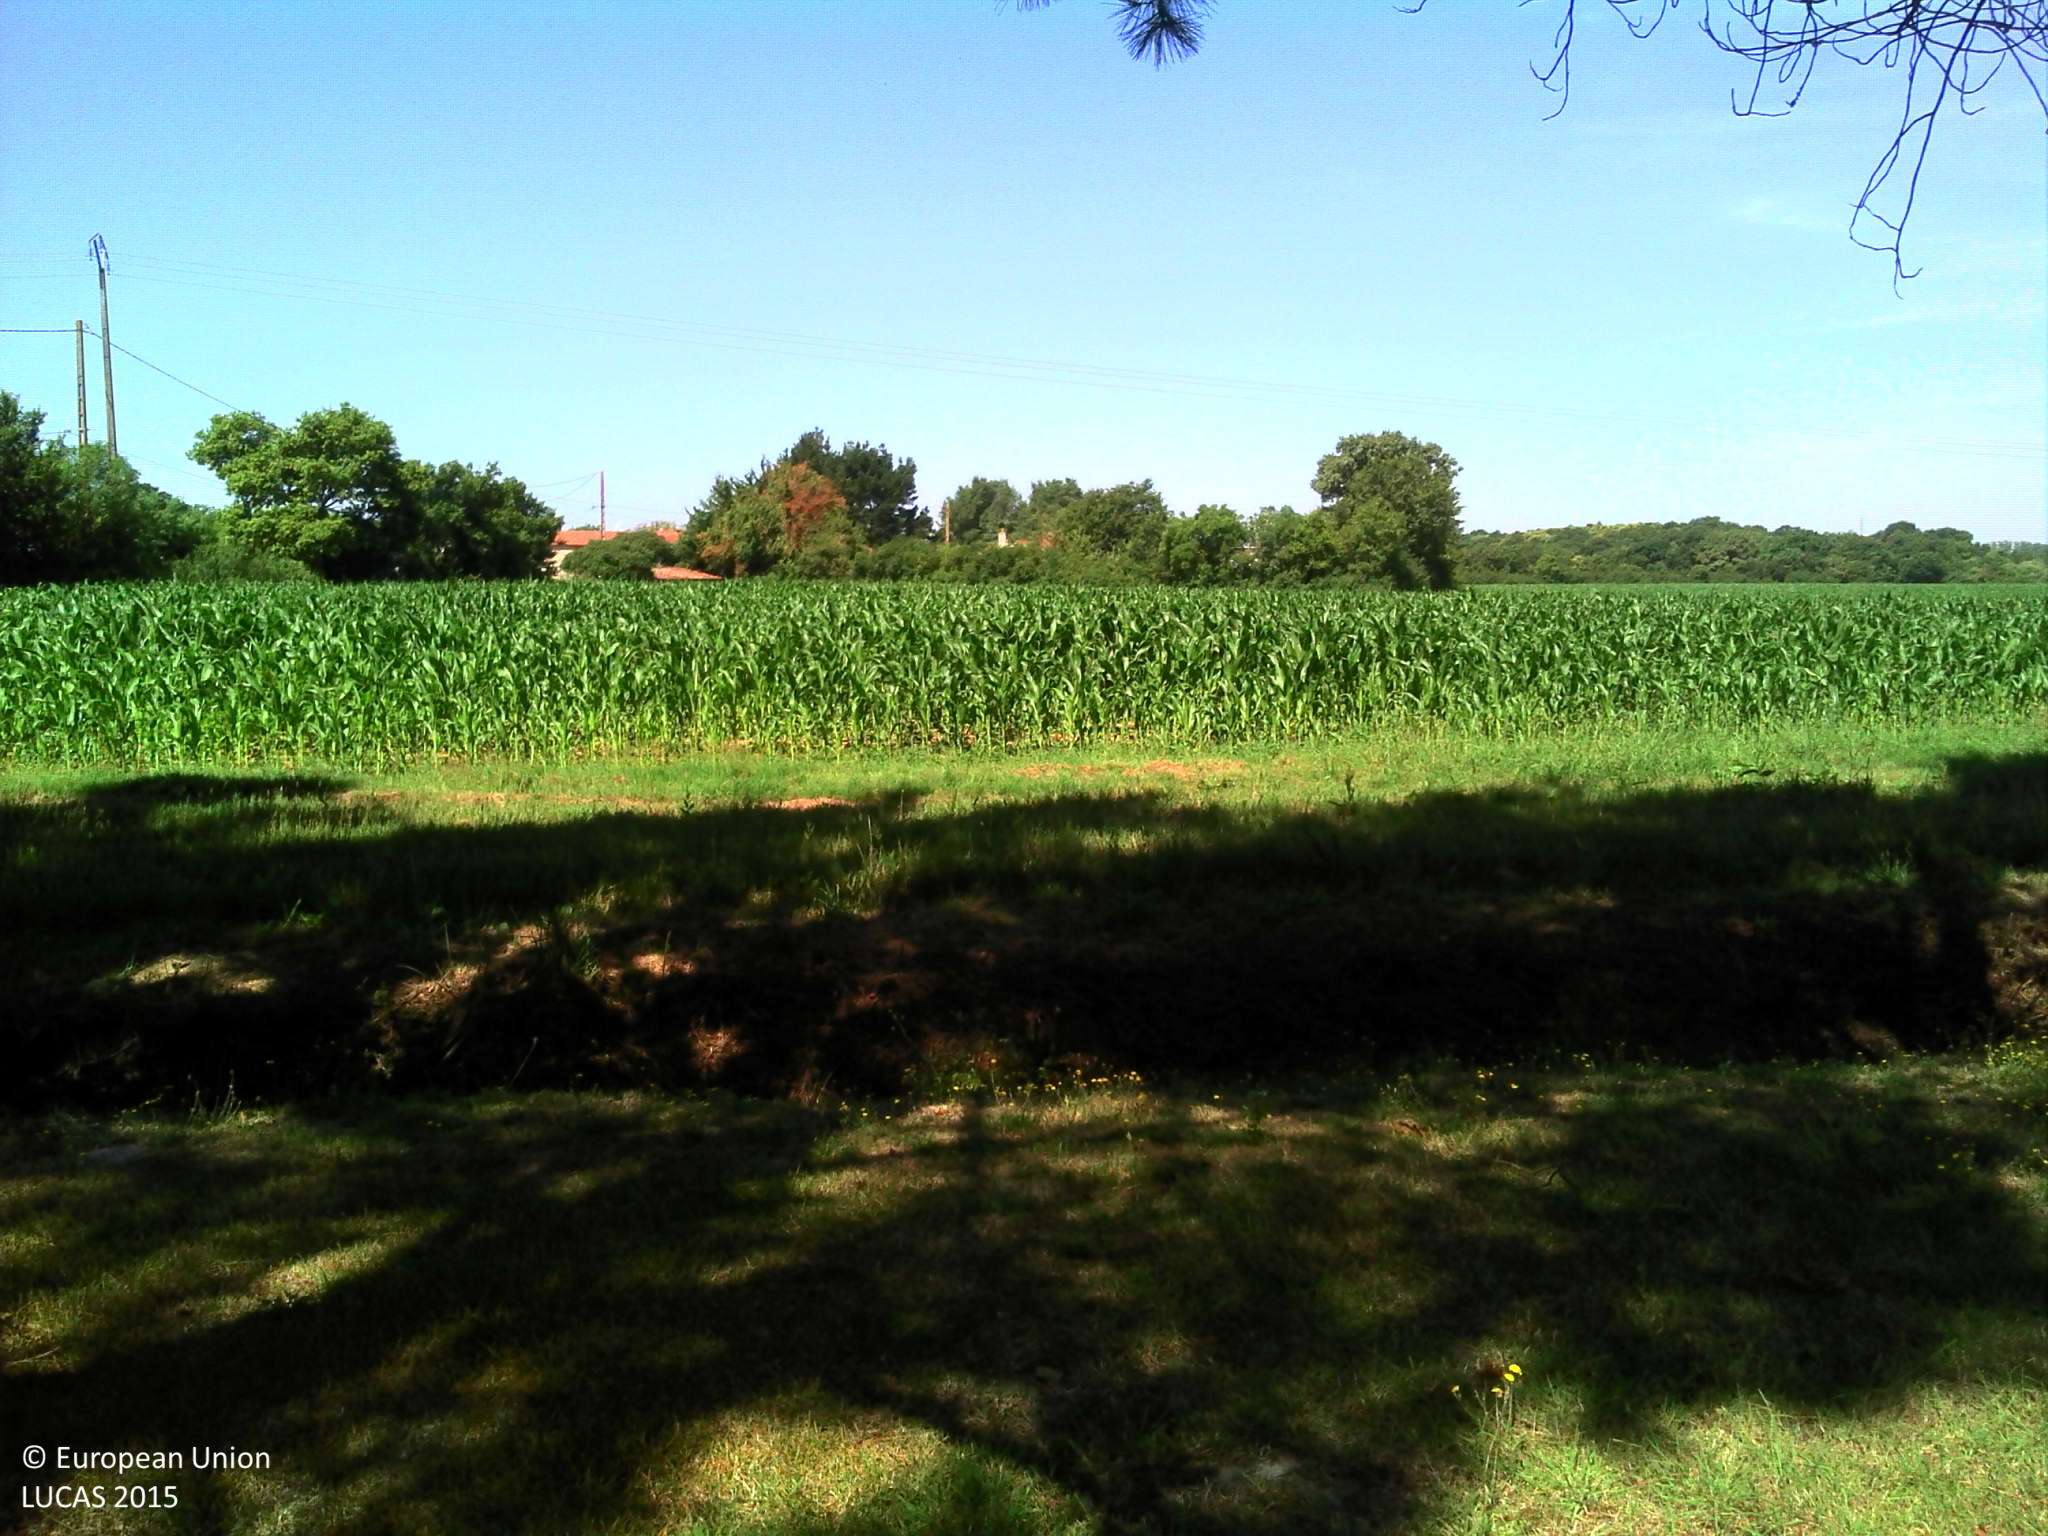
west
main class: Grassland
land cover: Grassland without tree/shrub cover
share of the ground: > 75 %
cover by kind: herbaceous plants 100 %
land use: Residential
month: June
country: FR
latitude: 46.8936
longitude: -1.6576
